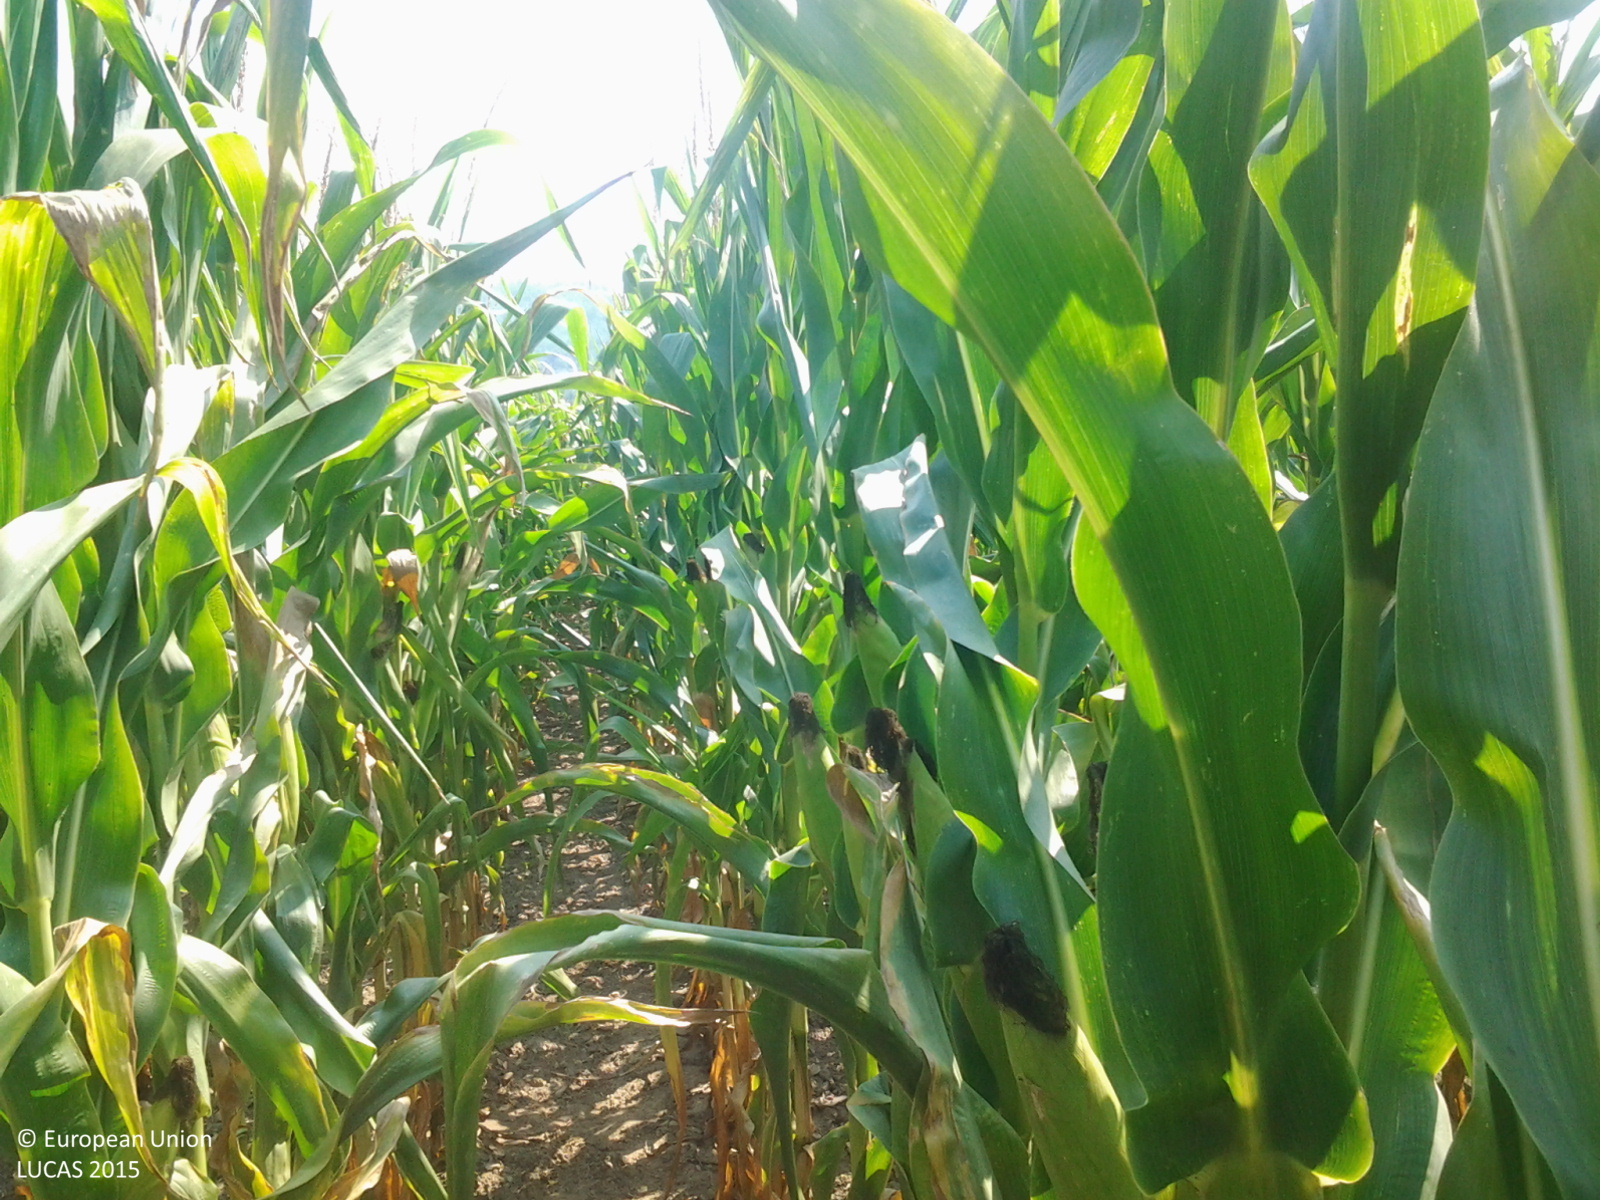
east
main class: Cropland
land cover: Maize
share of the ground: > 75 %
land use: Agriculture (excluding fallow land and kitchen gardens)
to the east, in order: Maize; Tracks; Common wheat
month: August
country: HU
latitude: 46.6172
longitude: 18.4067
